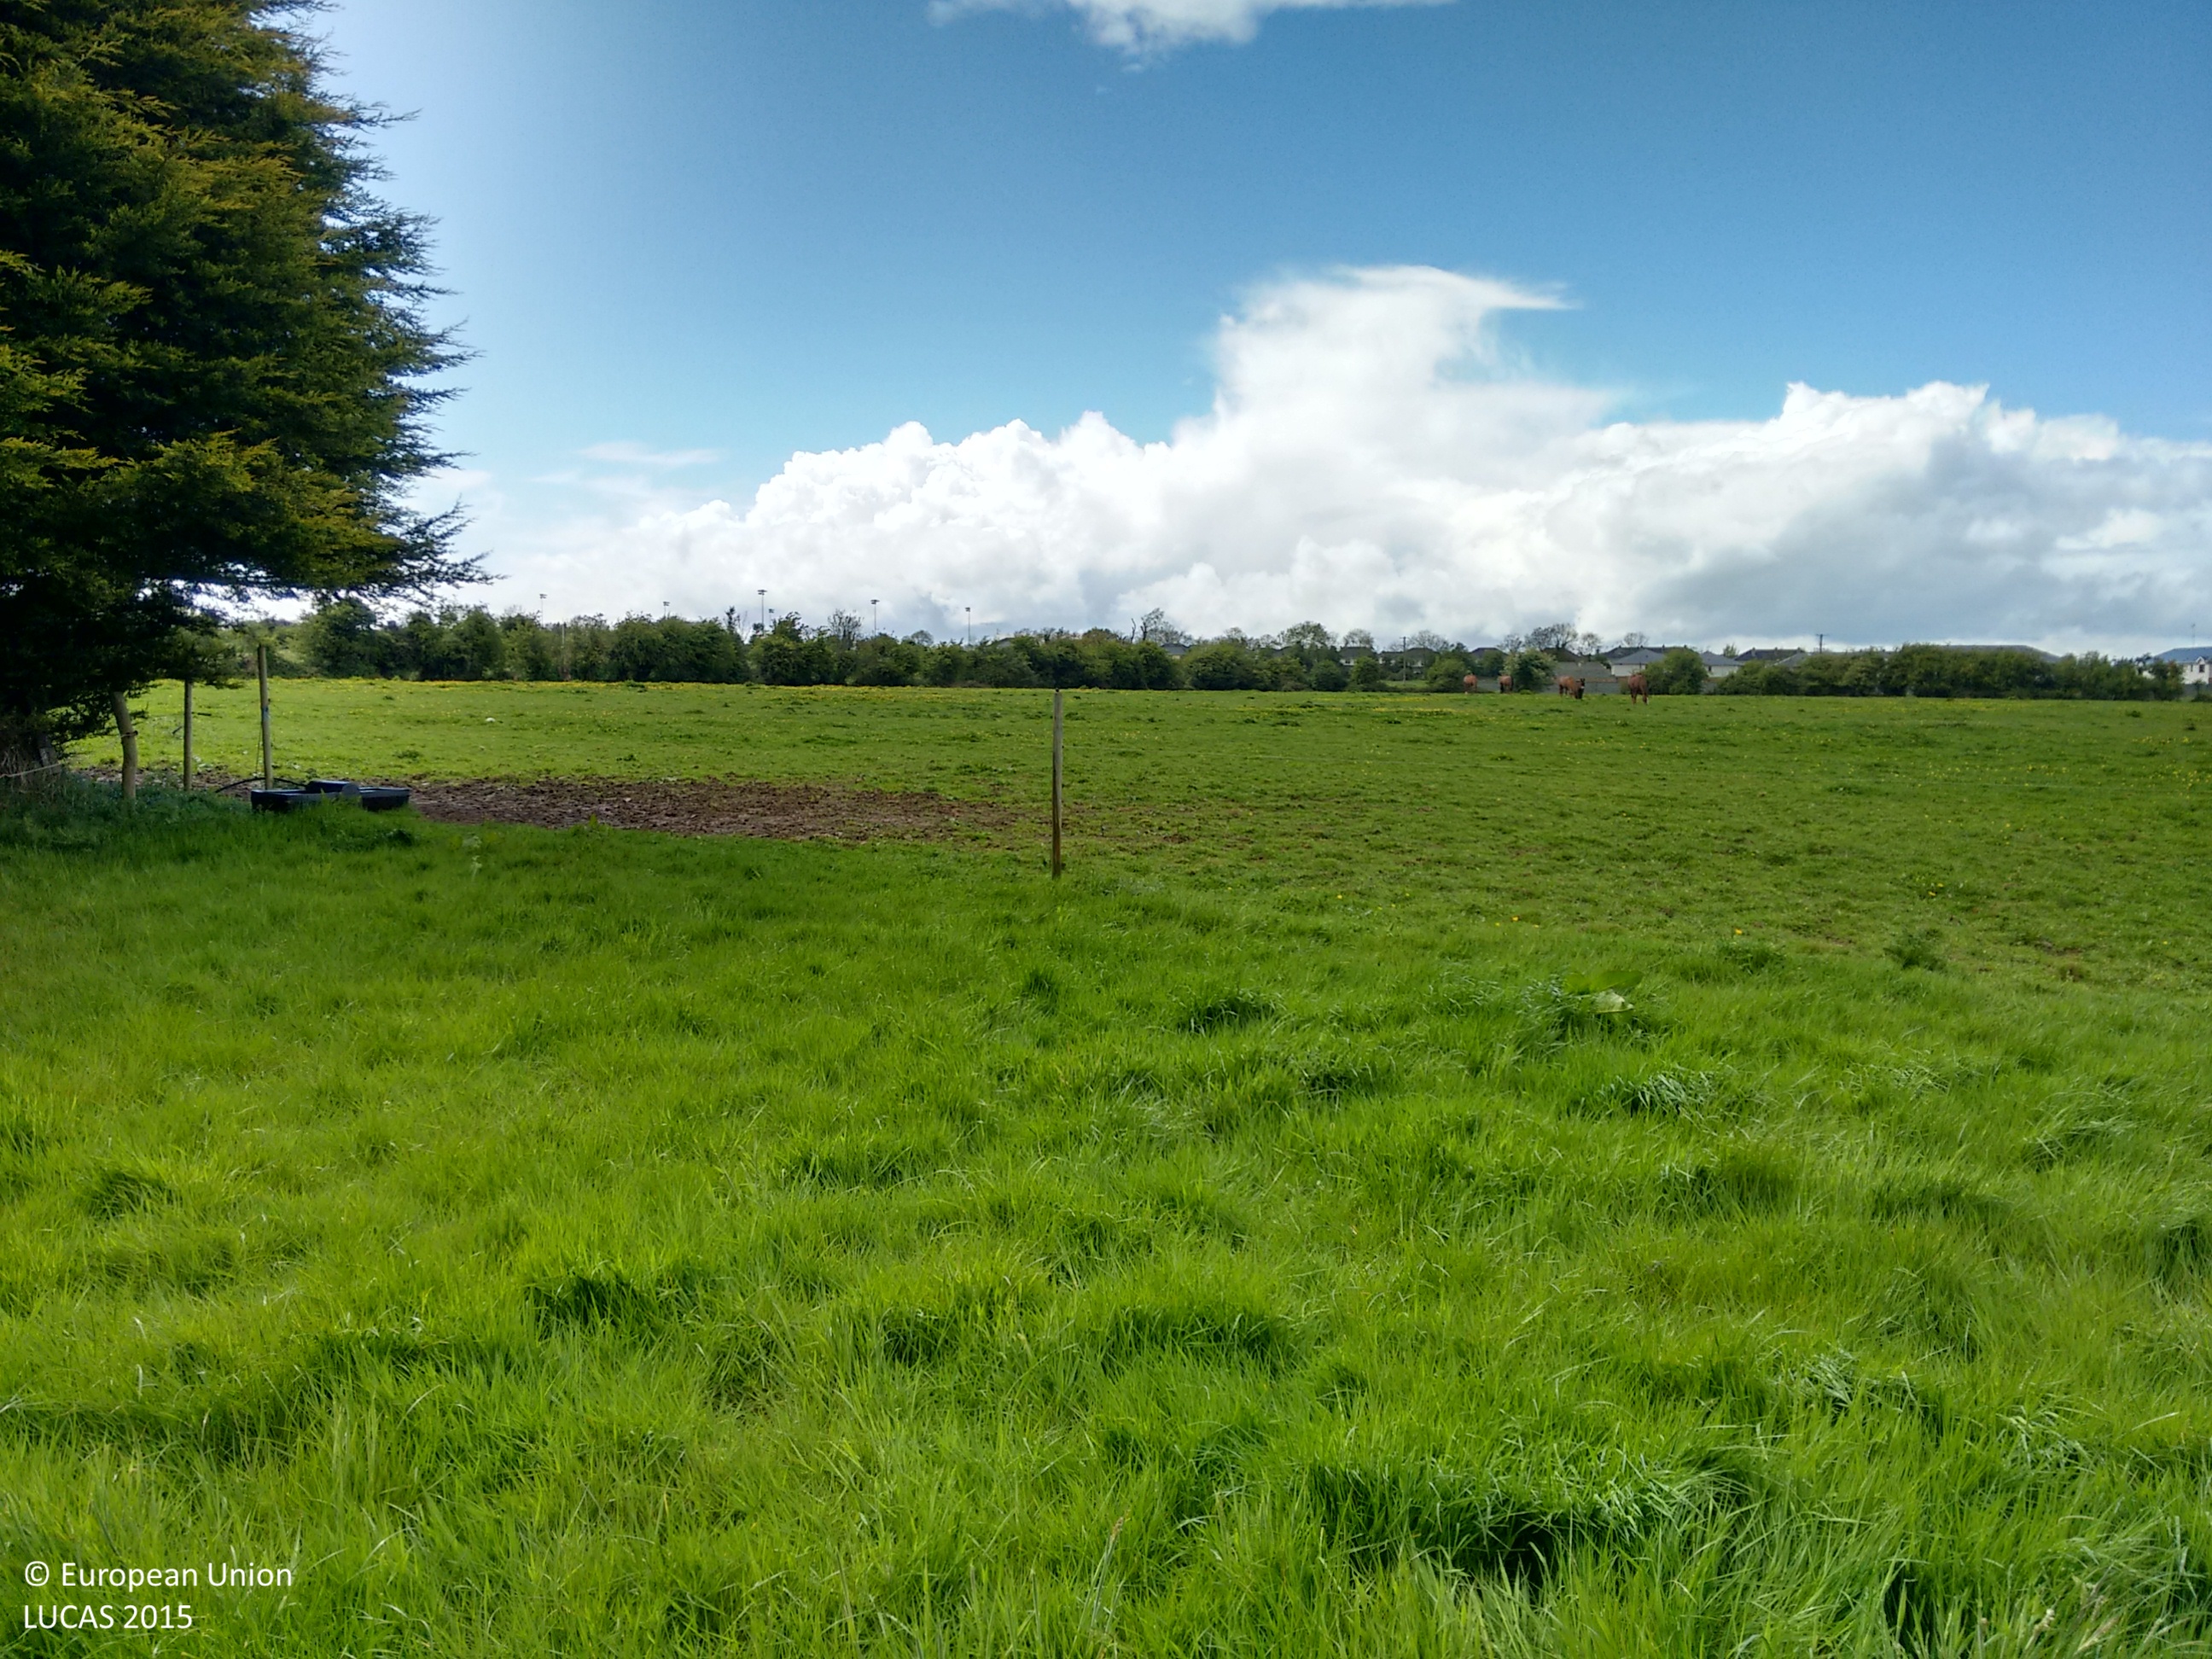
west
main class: Grassland
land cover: Grassland without tree/shrub cover
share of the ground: > 75 %
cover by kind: herbaceous plants 100 %
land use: Agriculture (excluding fallow land and kitchen gardens)
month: May
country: IE
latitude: 53.3944
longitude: -6.6584
